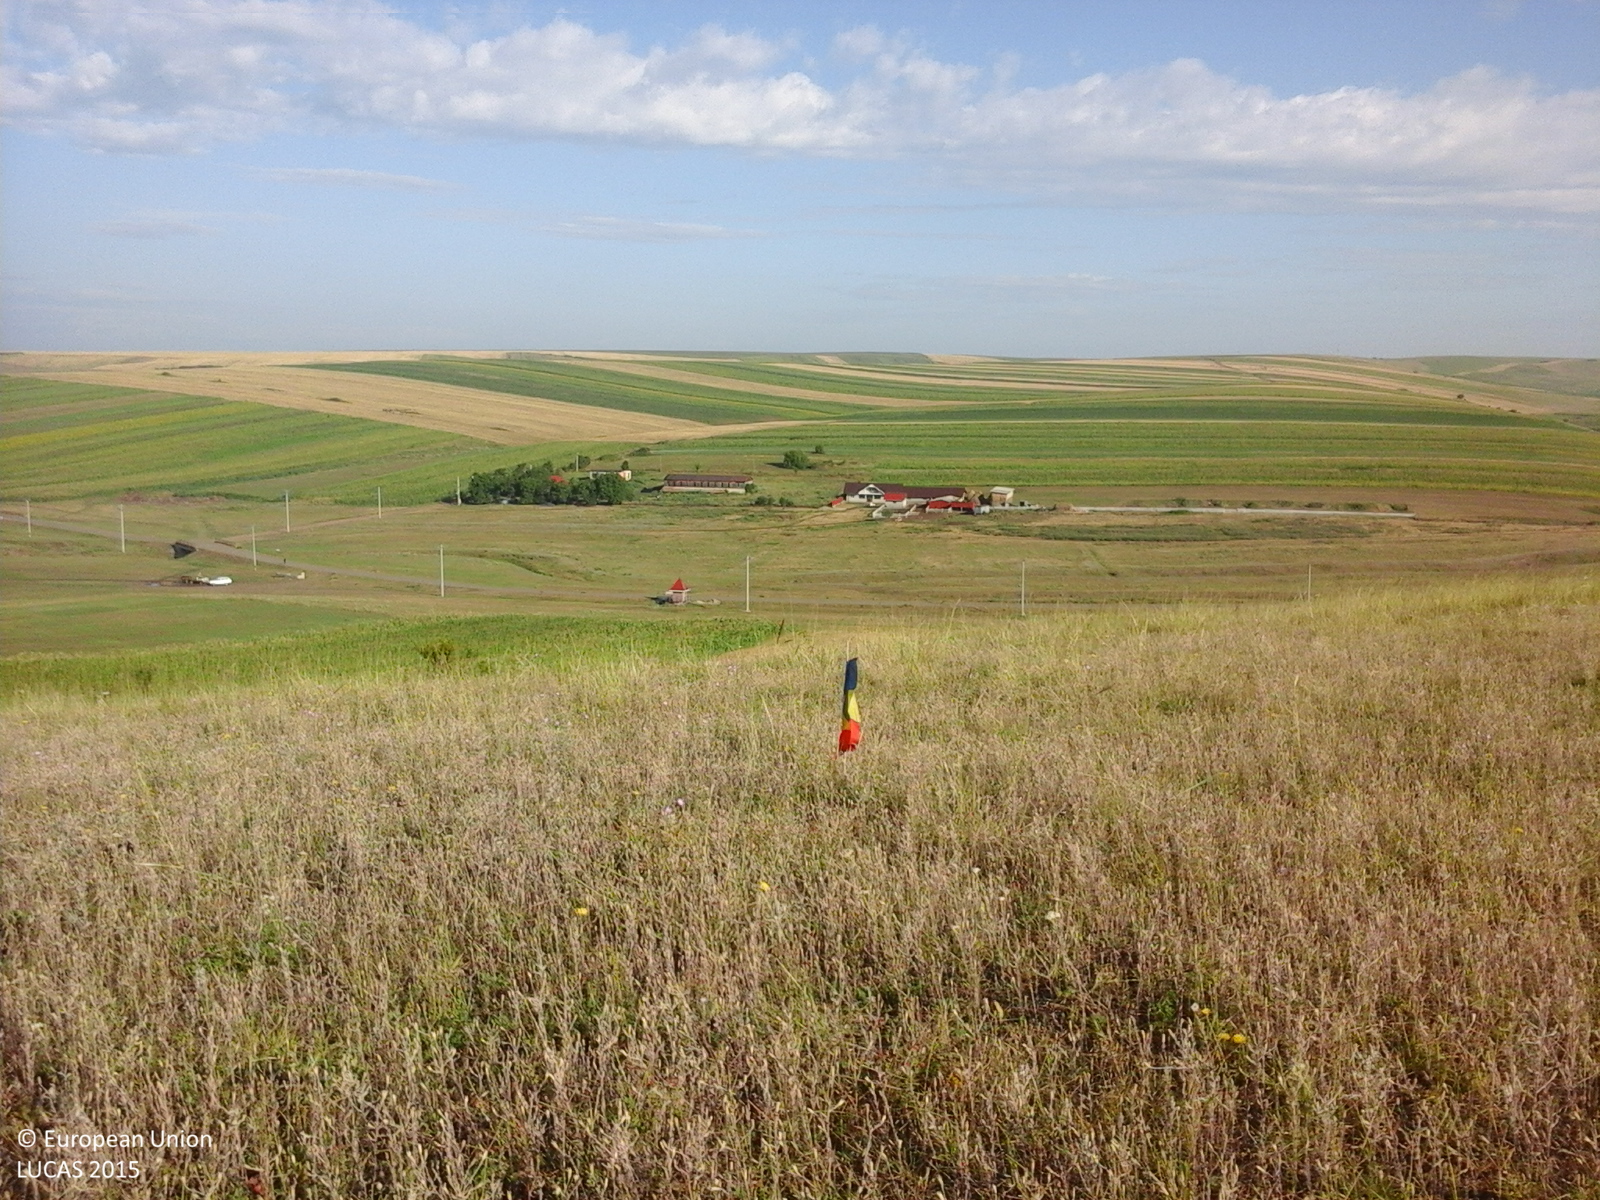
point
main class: Grassland
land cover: Grassland without tree/shrub cover
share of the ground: > 75 %
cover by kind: herbaceous plants 100 %
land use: Agriculture (excluding fallow land and kitchen gardens)
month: July
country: RO
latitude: 46.1959
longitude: 27.7522
